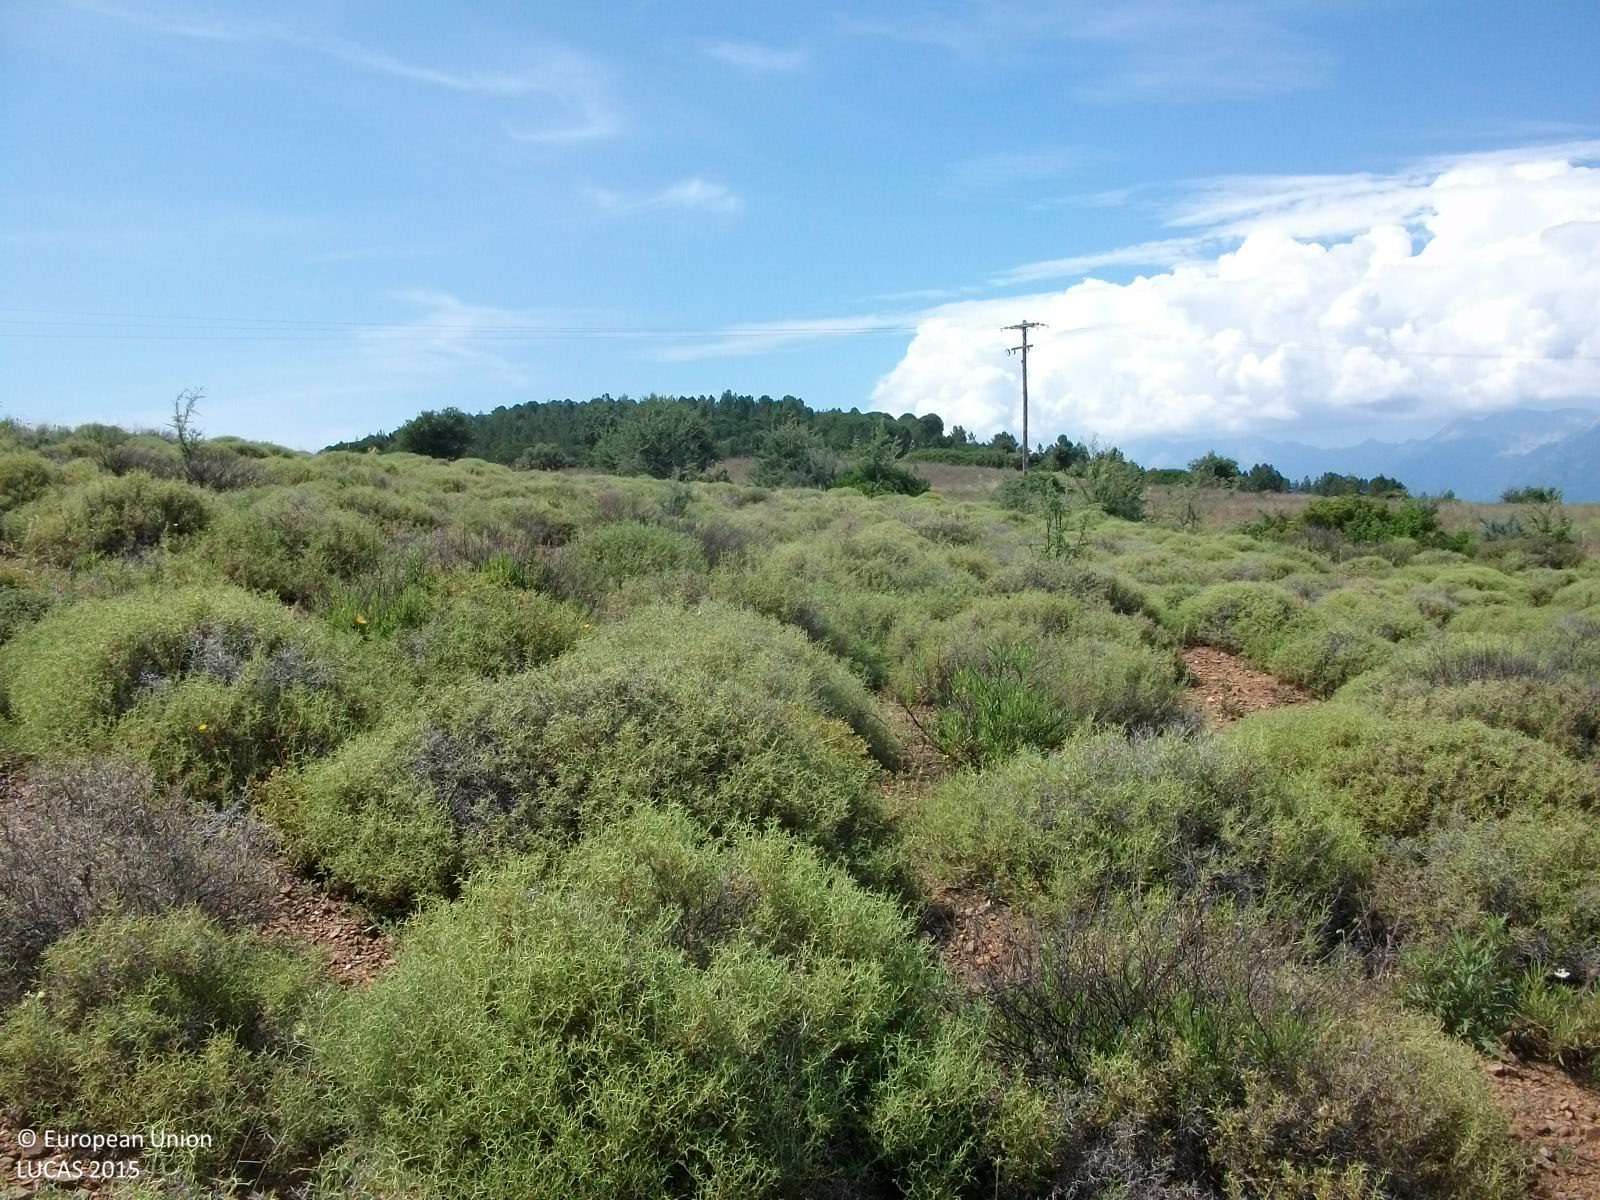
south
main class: Shrubland
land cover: Shrubland without tree cover
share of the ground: > 75 %
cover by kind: shrubs 85 %, consolidated bare surface 10 %, herbaceous plants 5 %
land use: Semi-natural and natural areas not in use
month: June
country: GR
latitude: 37.1855
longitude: 22.4273
